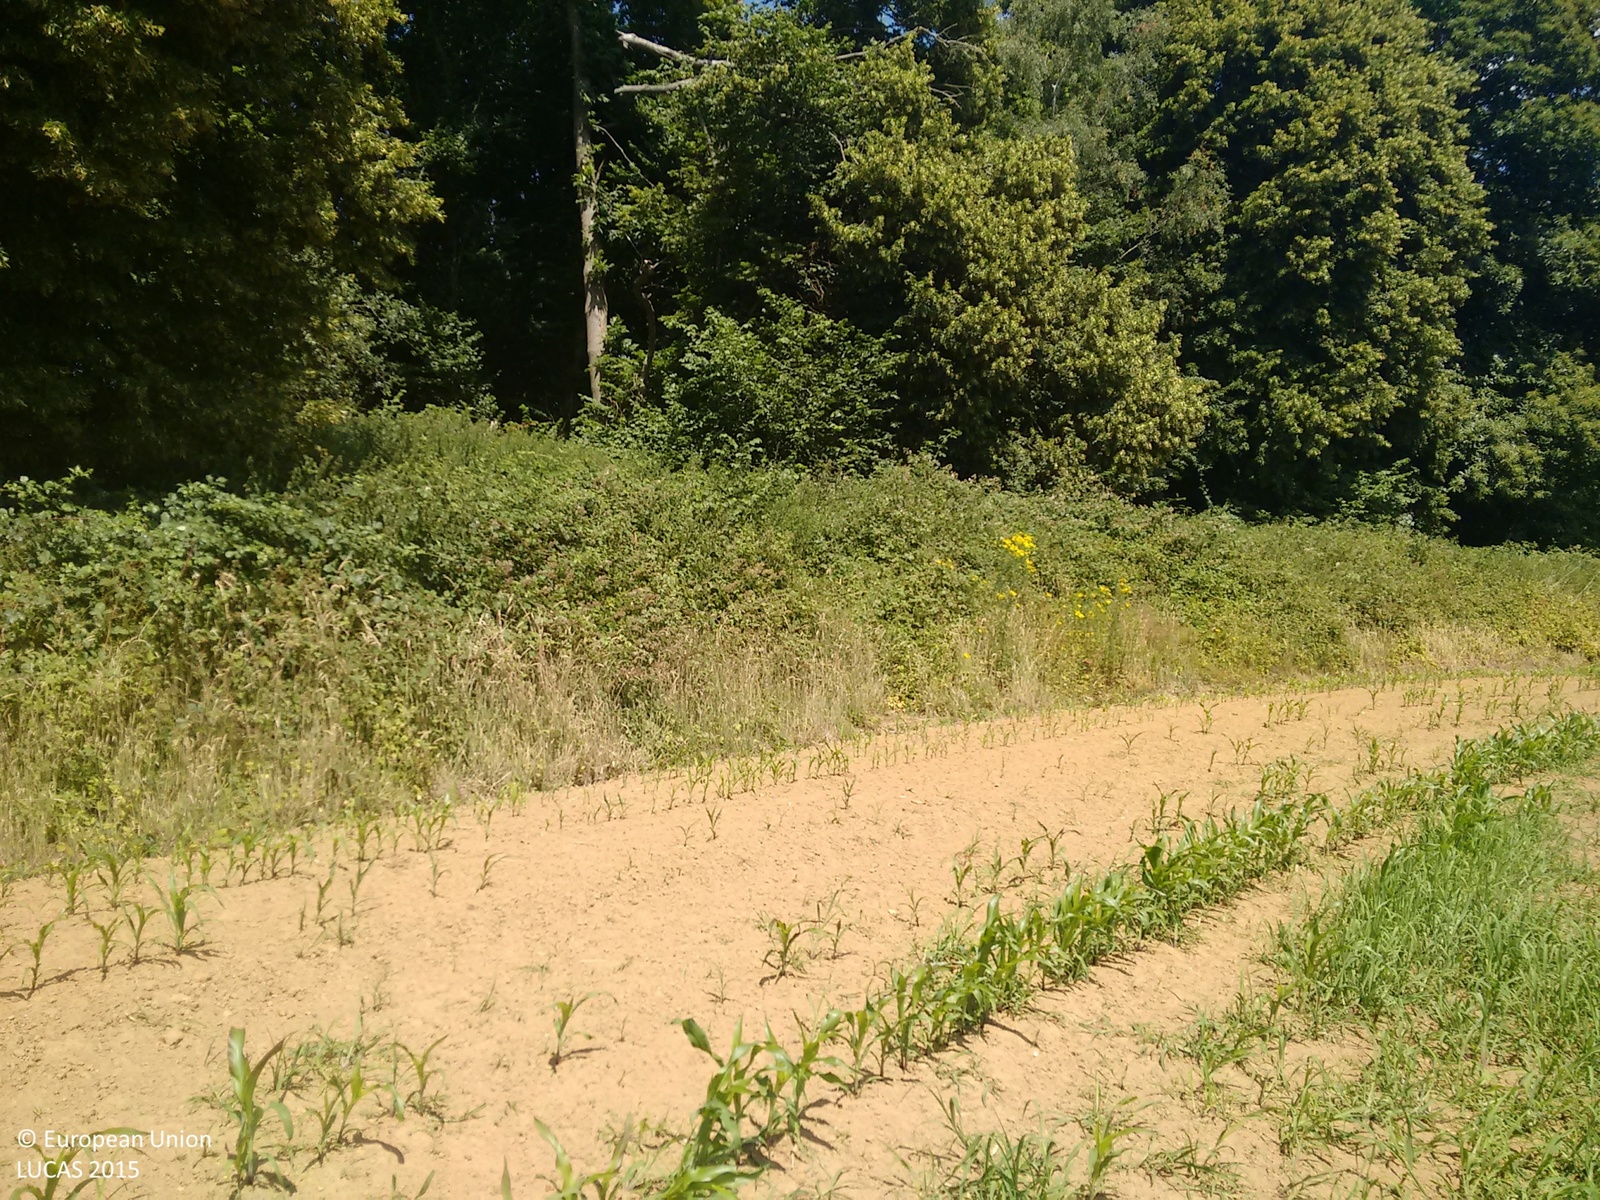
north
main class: Cropland
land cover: Maize
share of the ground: 10 - 25 %
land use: Agriculture (excluding fallow land and kitchen gardens)
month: July
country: GB
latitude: 51.1802
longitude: -0.5534
